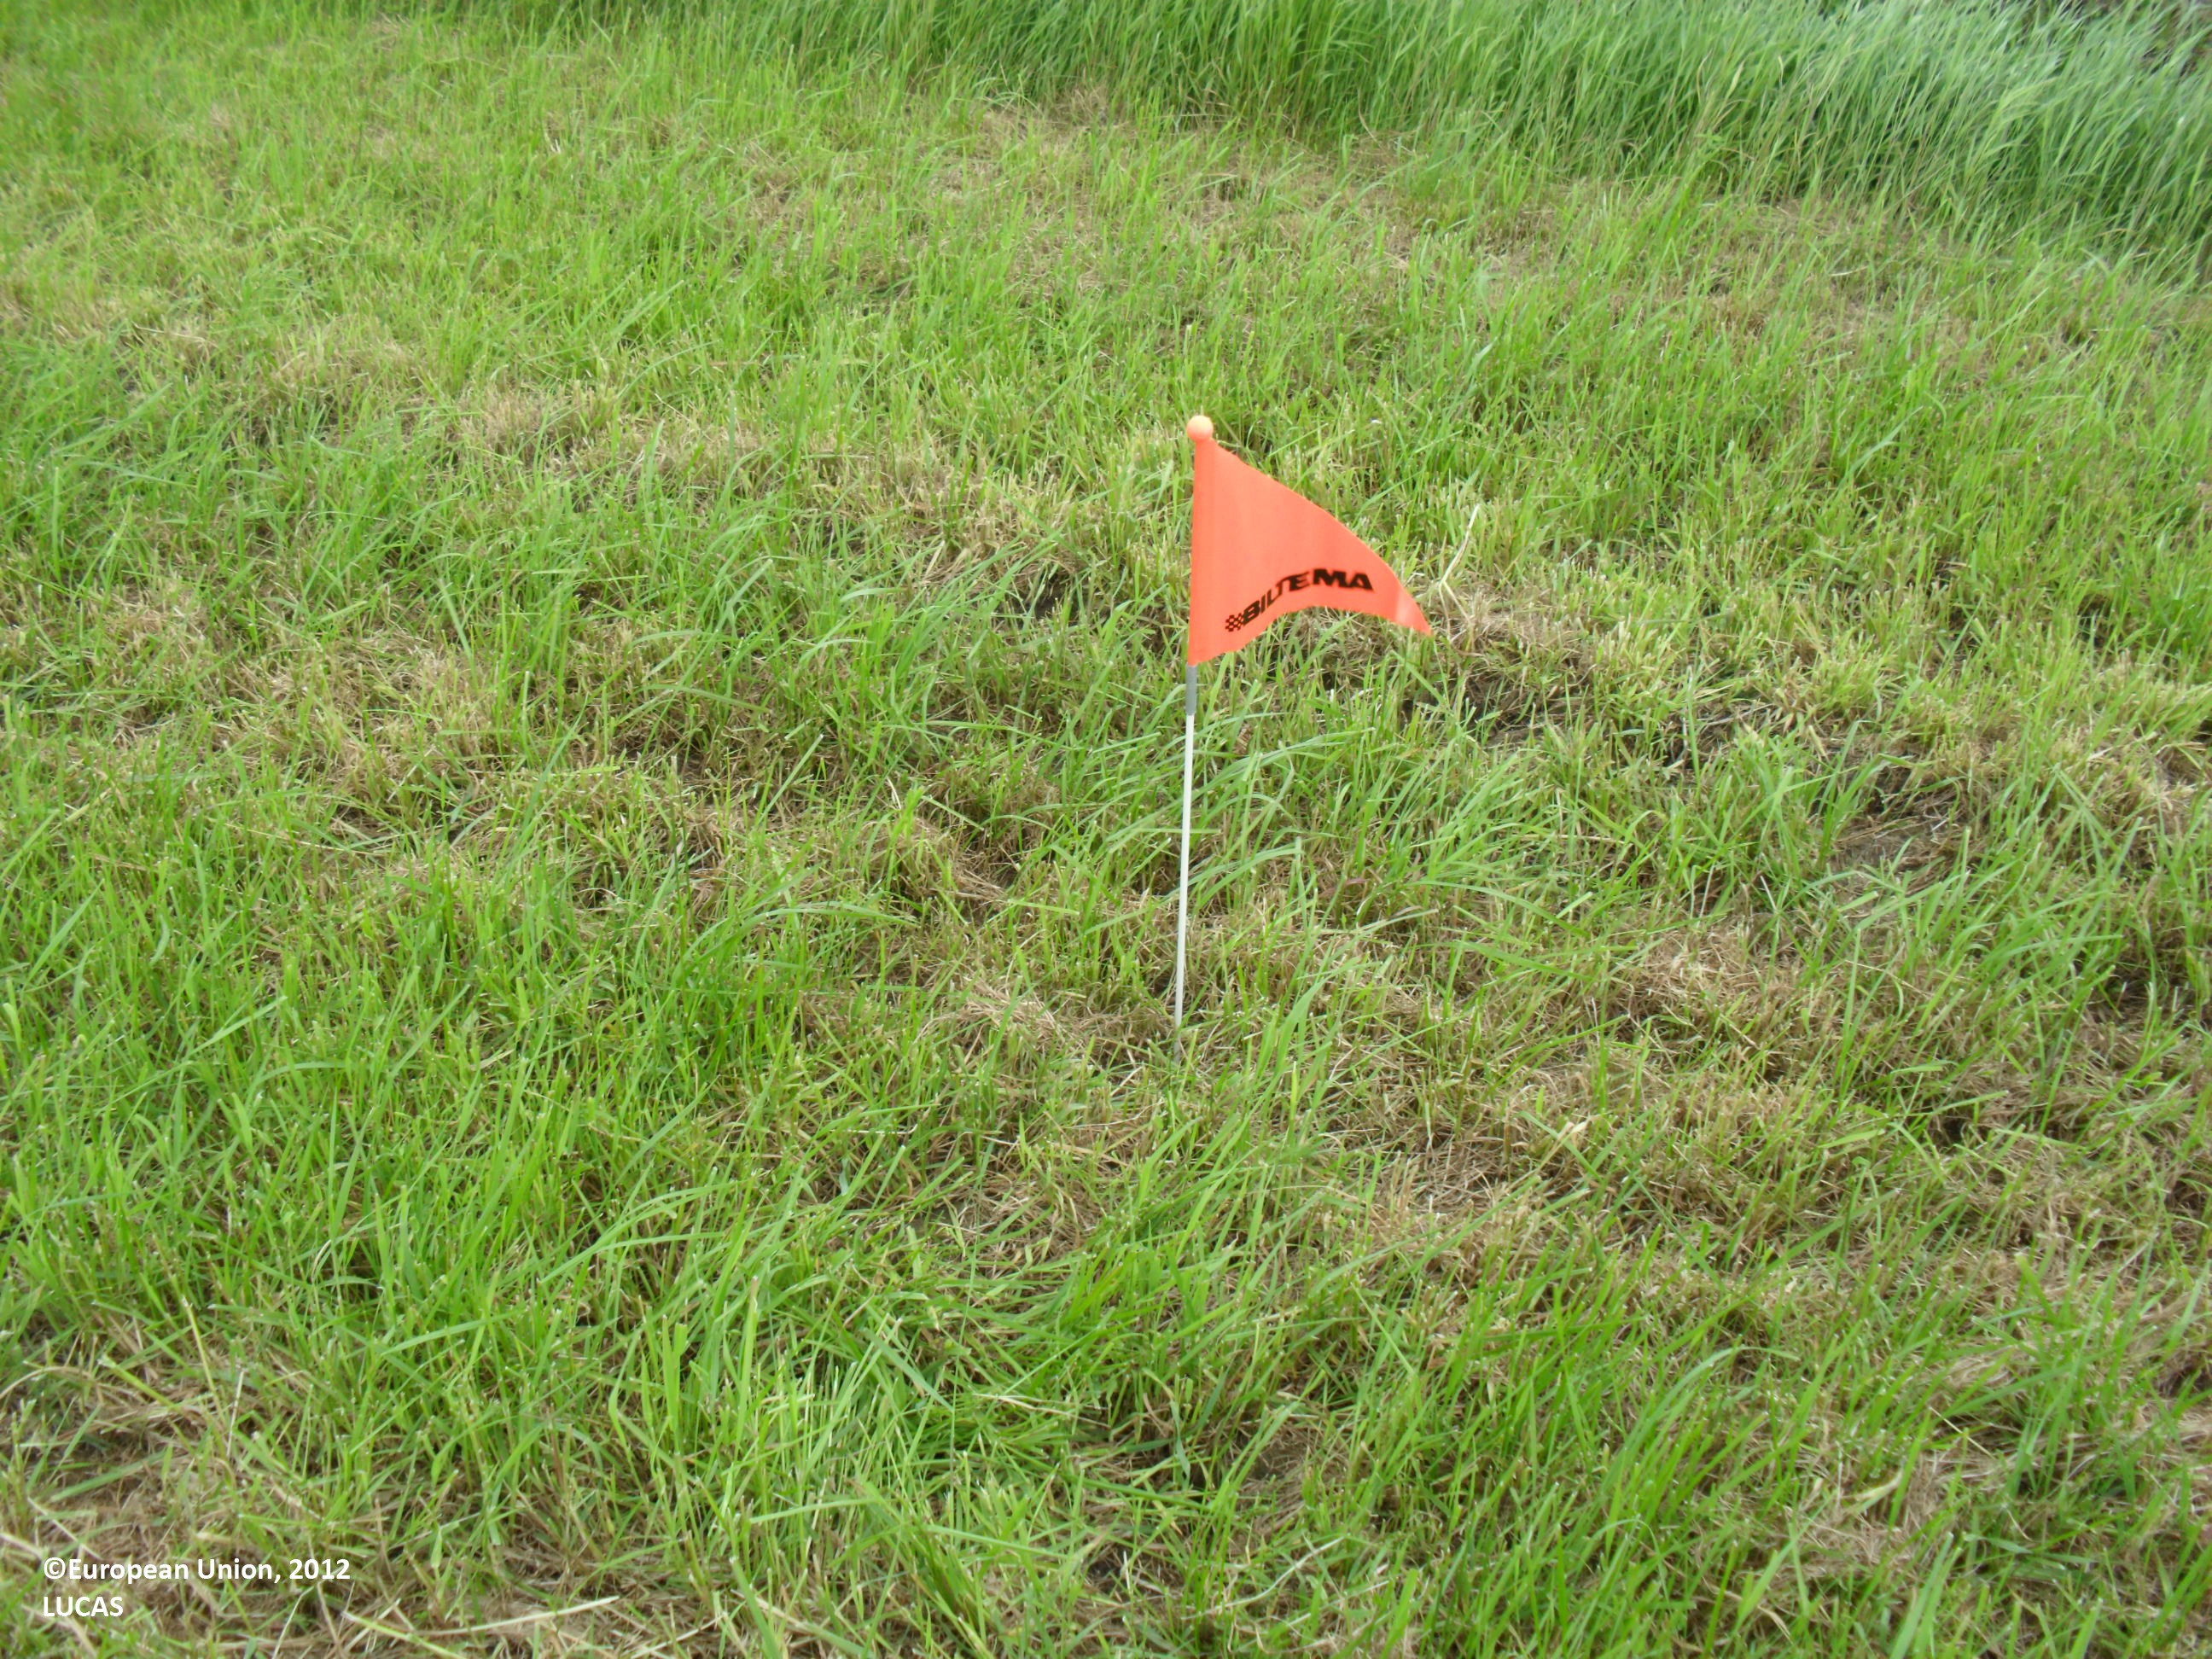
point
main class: Grassland
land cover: Grassland without tree/shrub cover
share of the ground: > 75 %
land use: Agriculture (excluding fallow land and kitchen gardens)
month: June
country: FI
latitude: 63.1375
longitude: 23.0918
